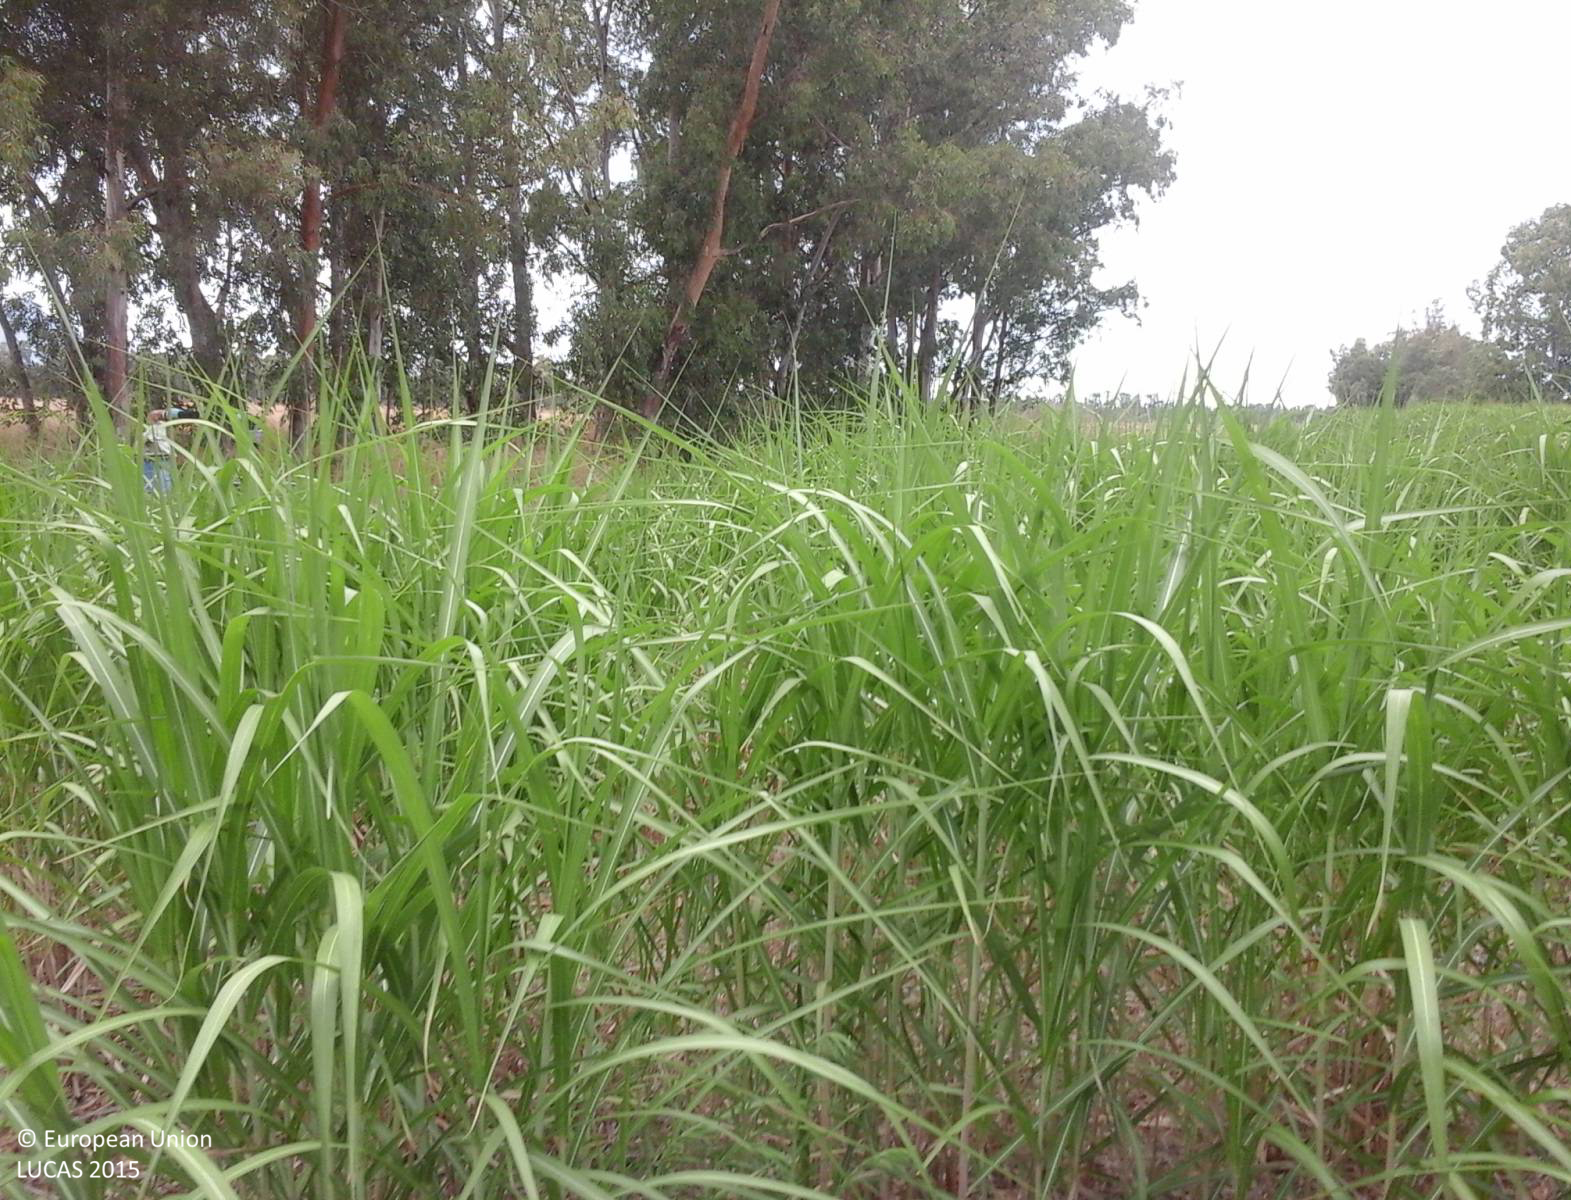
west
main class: Cropland
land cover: Permanent industrial crops
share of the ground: > 75 %
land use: Agriculture (excluding fallow land and kitchen gardens)
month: July
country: IT
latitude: 39.4638
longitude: 8.8562
